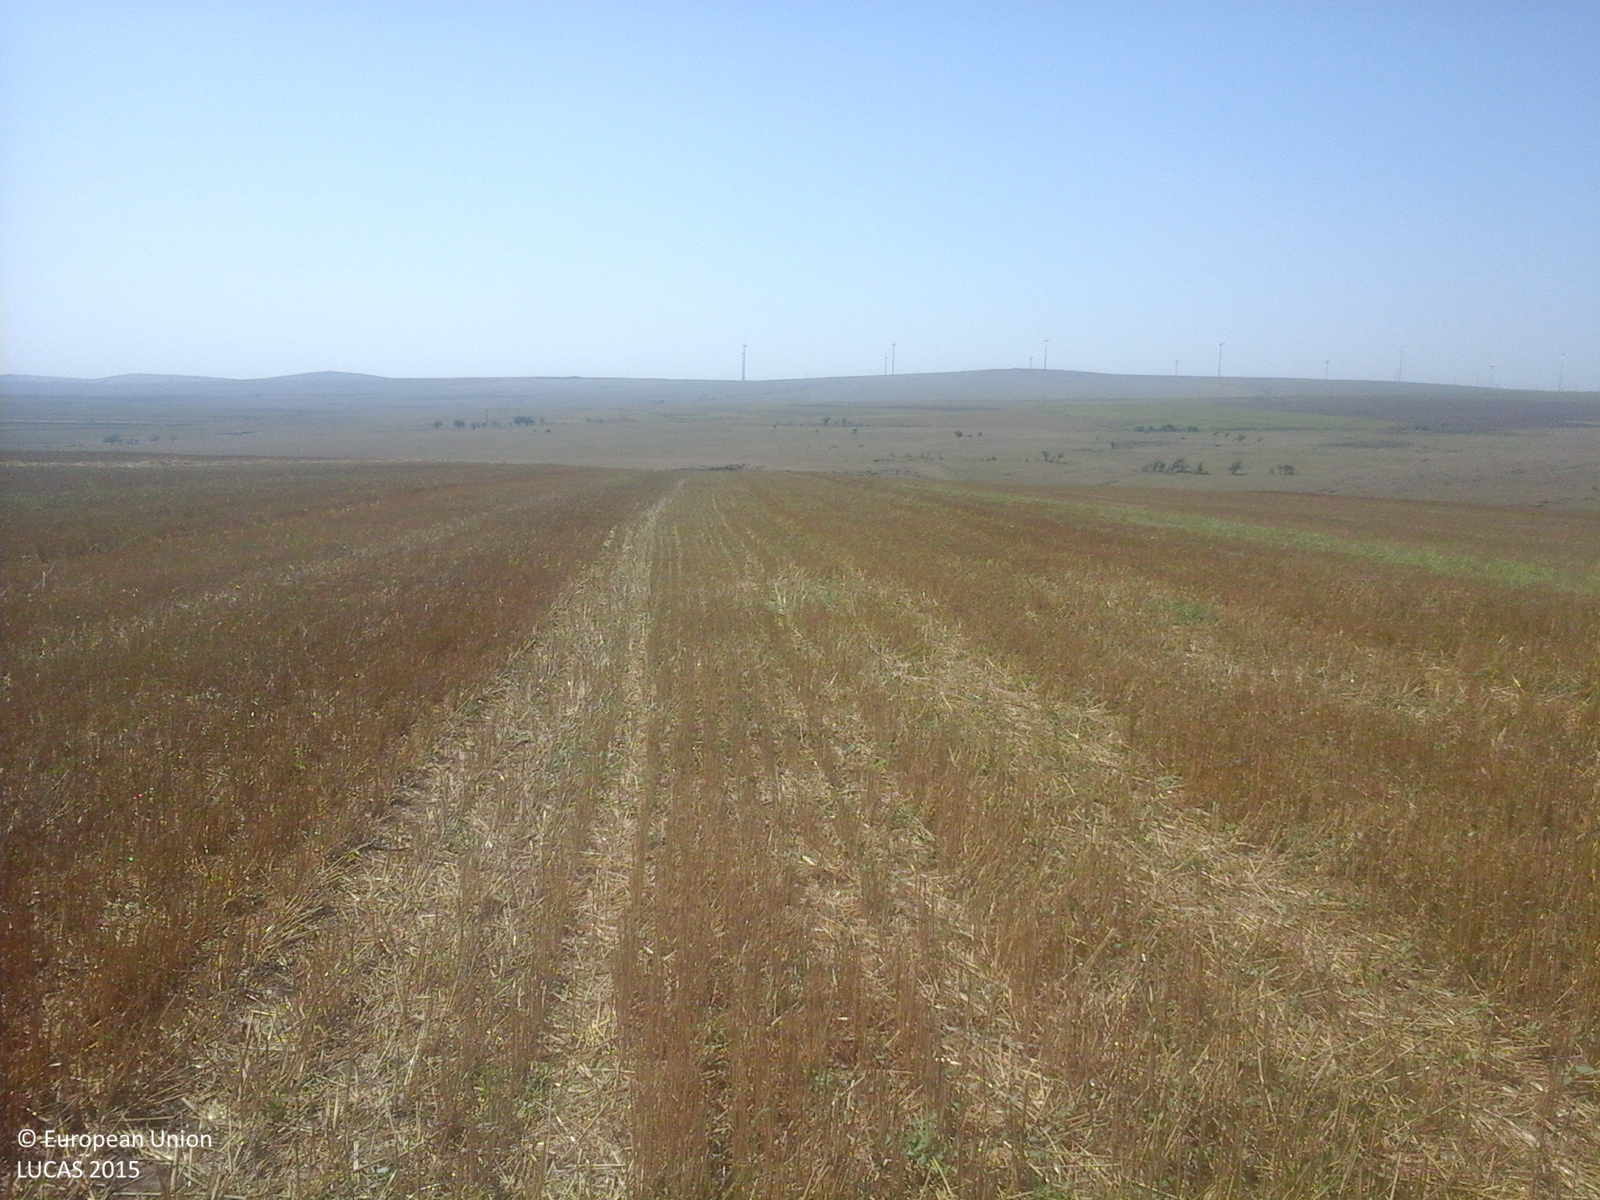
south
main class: Cropland
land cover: Common wheat
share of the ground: > 75 %
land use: Agriculture (excluding fallow land and kitchen gardens)
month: August
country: RO
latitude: 44.5765
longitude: 28.3679
